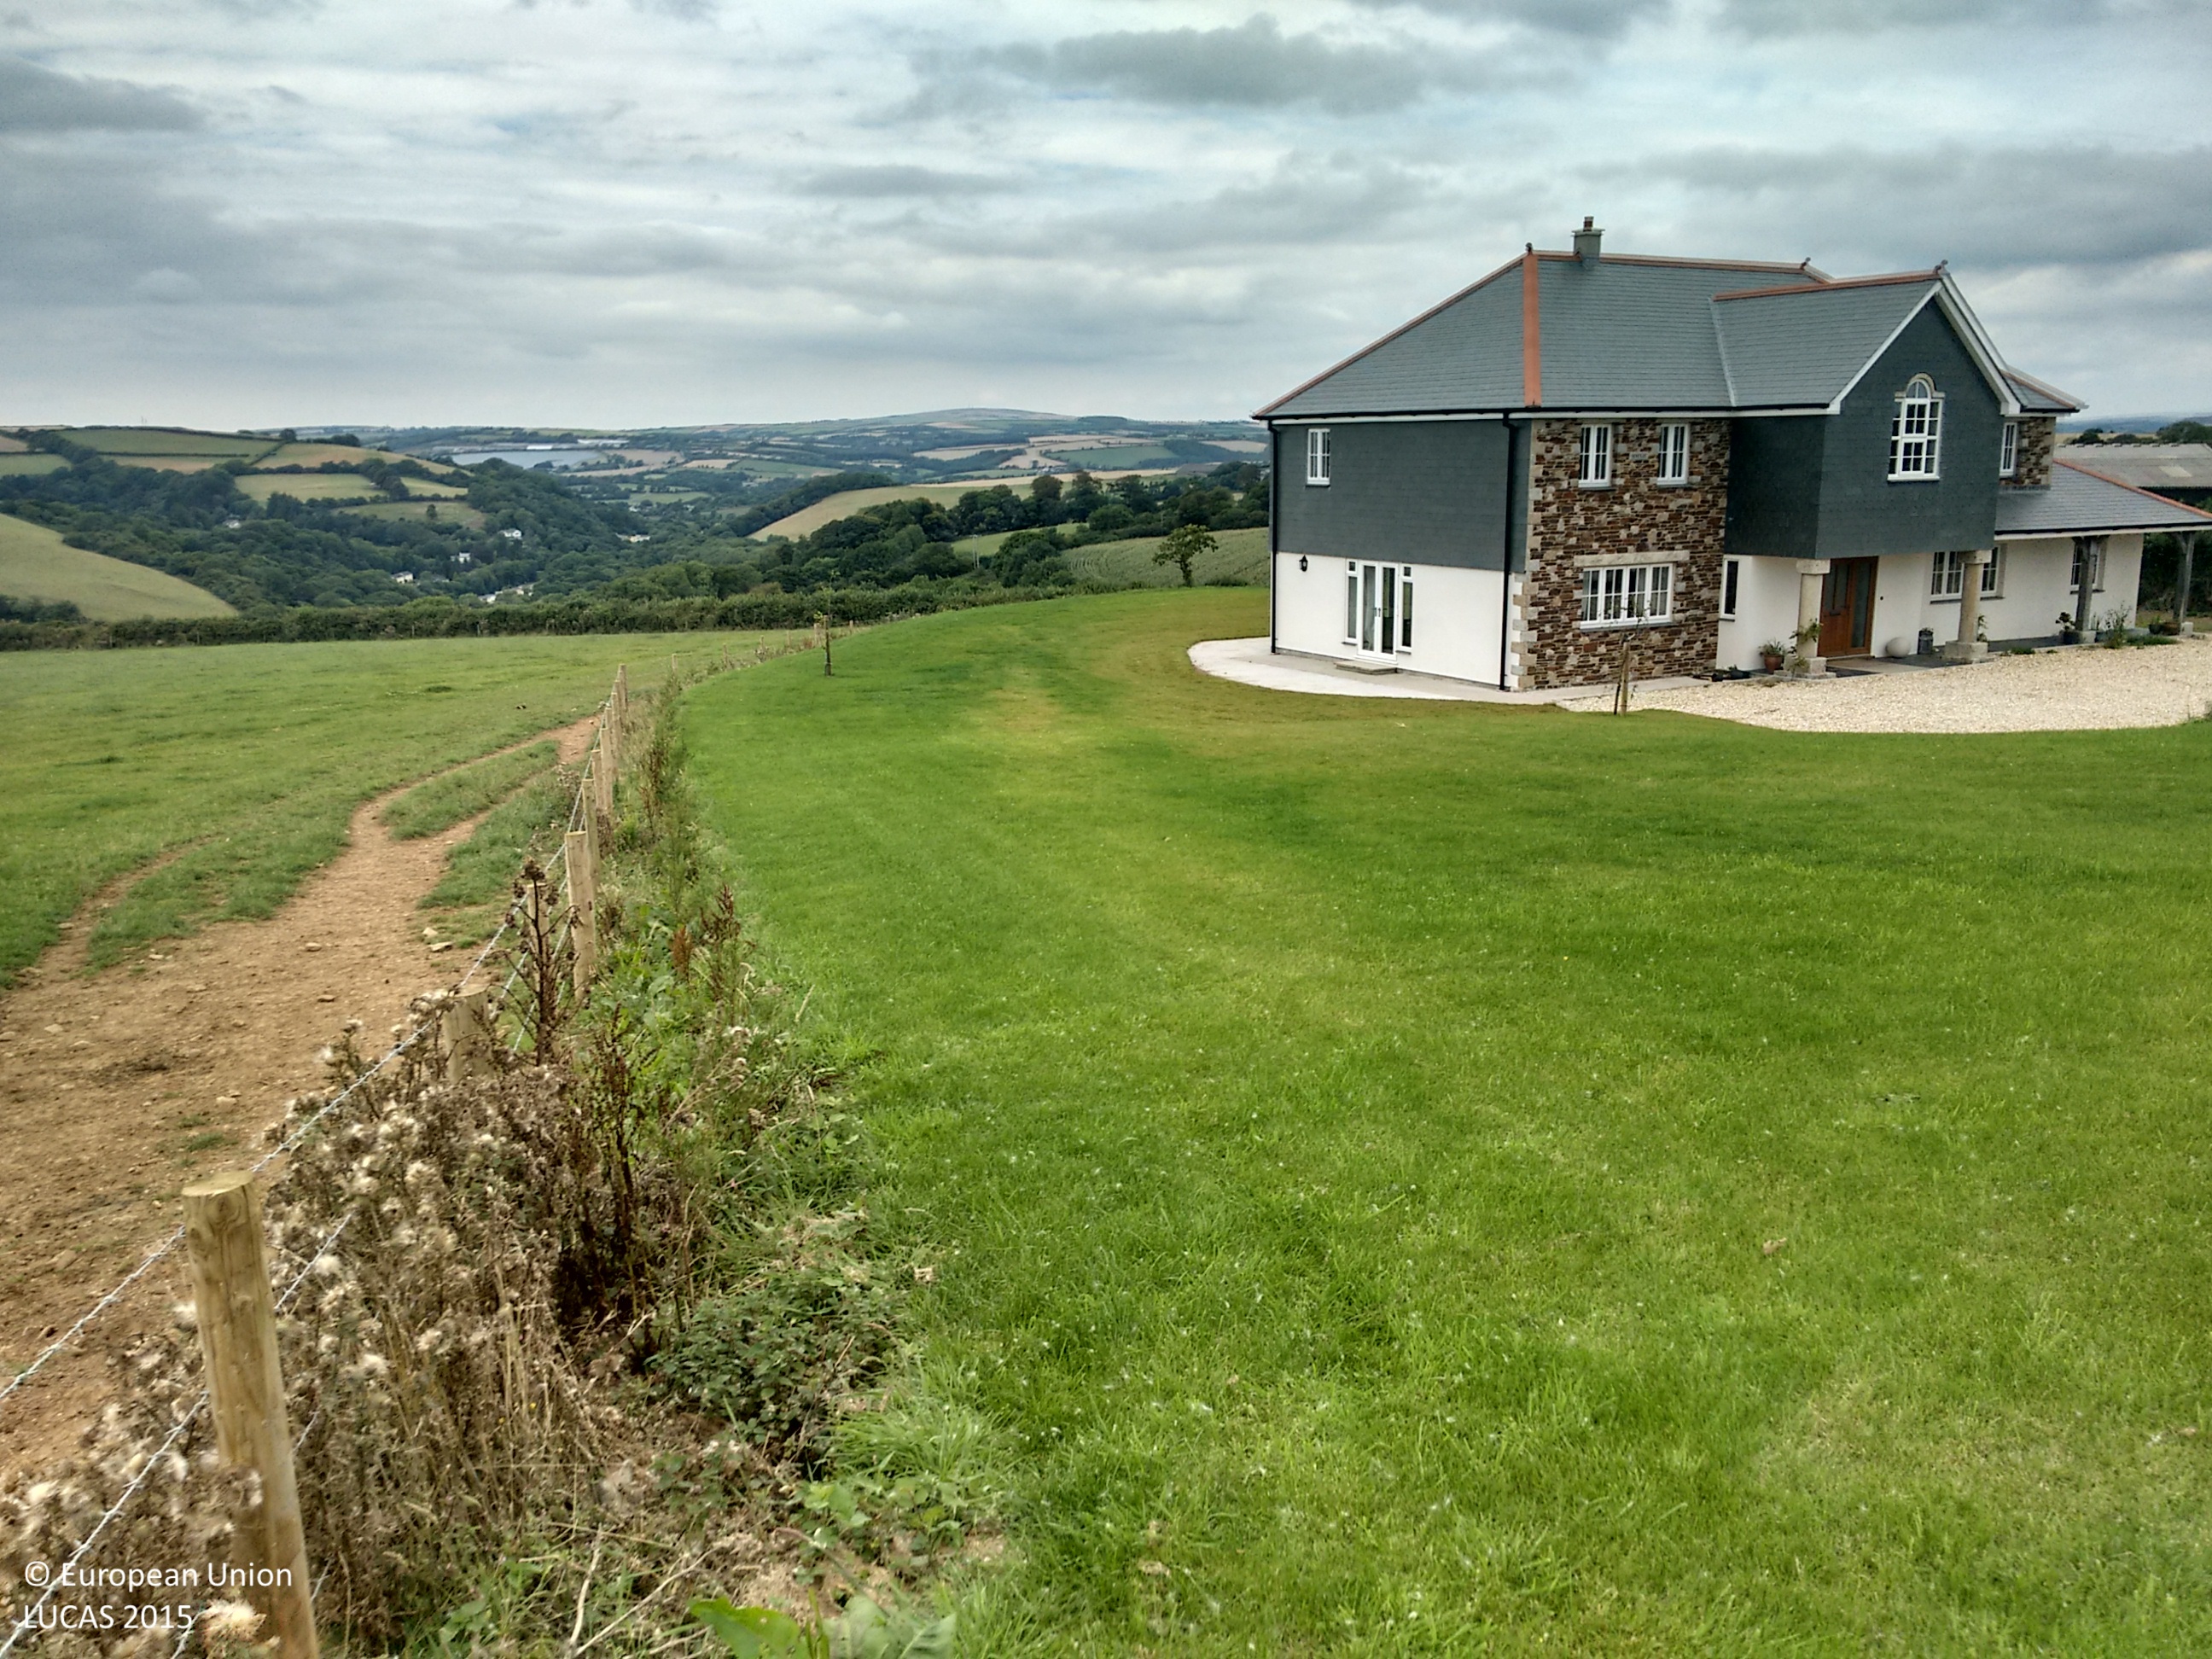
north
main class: Grassland
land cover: Grassland without tree/shrub cover
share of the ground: > 75 %
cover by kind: herbaceous plants 100 %
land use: Agriculture (excluding fallow land and kitchen gardens)
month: August
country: GB
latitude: 50.4131
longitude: -4.2702
